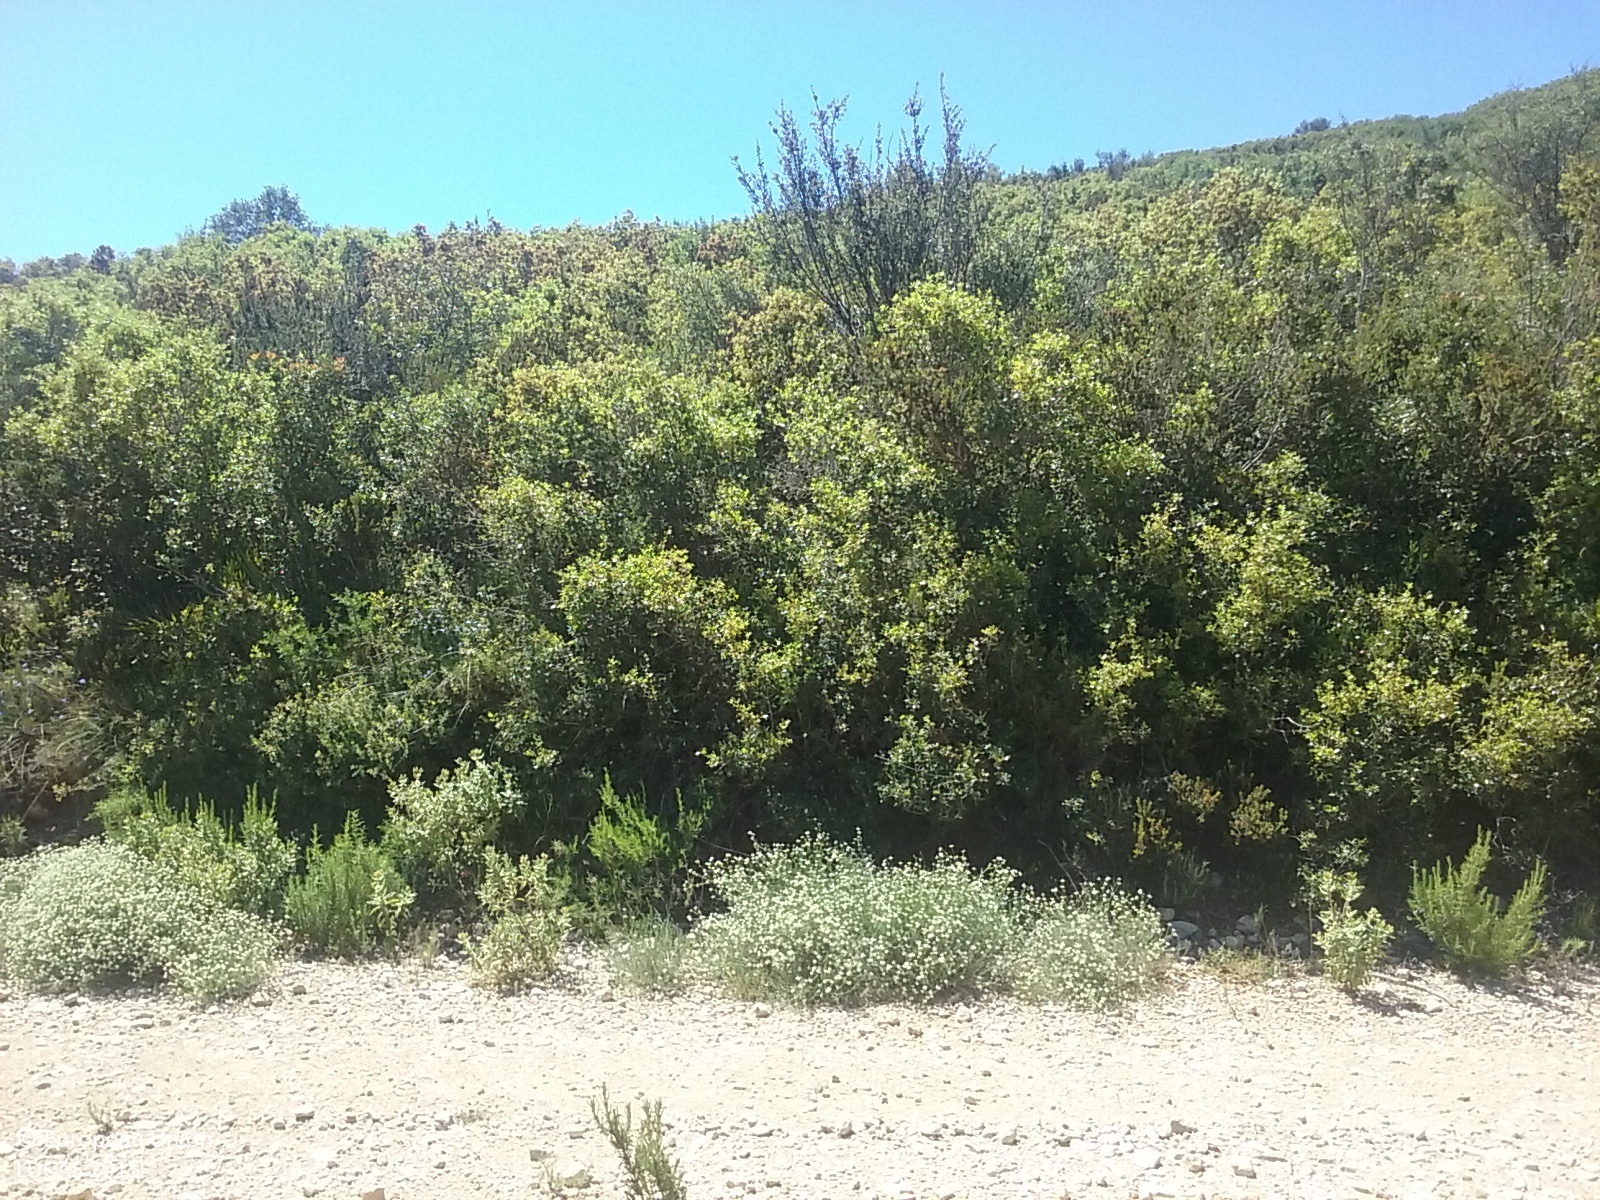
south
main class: Shrubland
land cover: Shrubland with sparse tree cover
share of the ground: > 75 %
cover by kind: shrubs 85 %, broadleaved forest trees 5 %
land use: Semi-natural and natural areas not in use
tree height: < 5 m
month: May
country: ES
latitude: 40.4763
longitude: 0.2880
